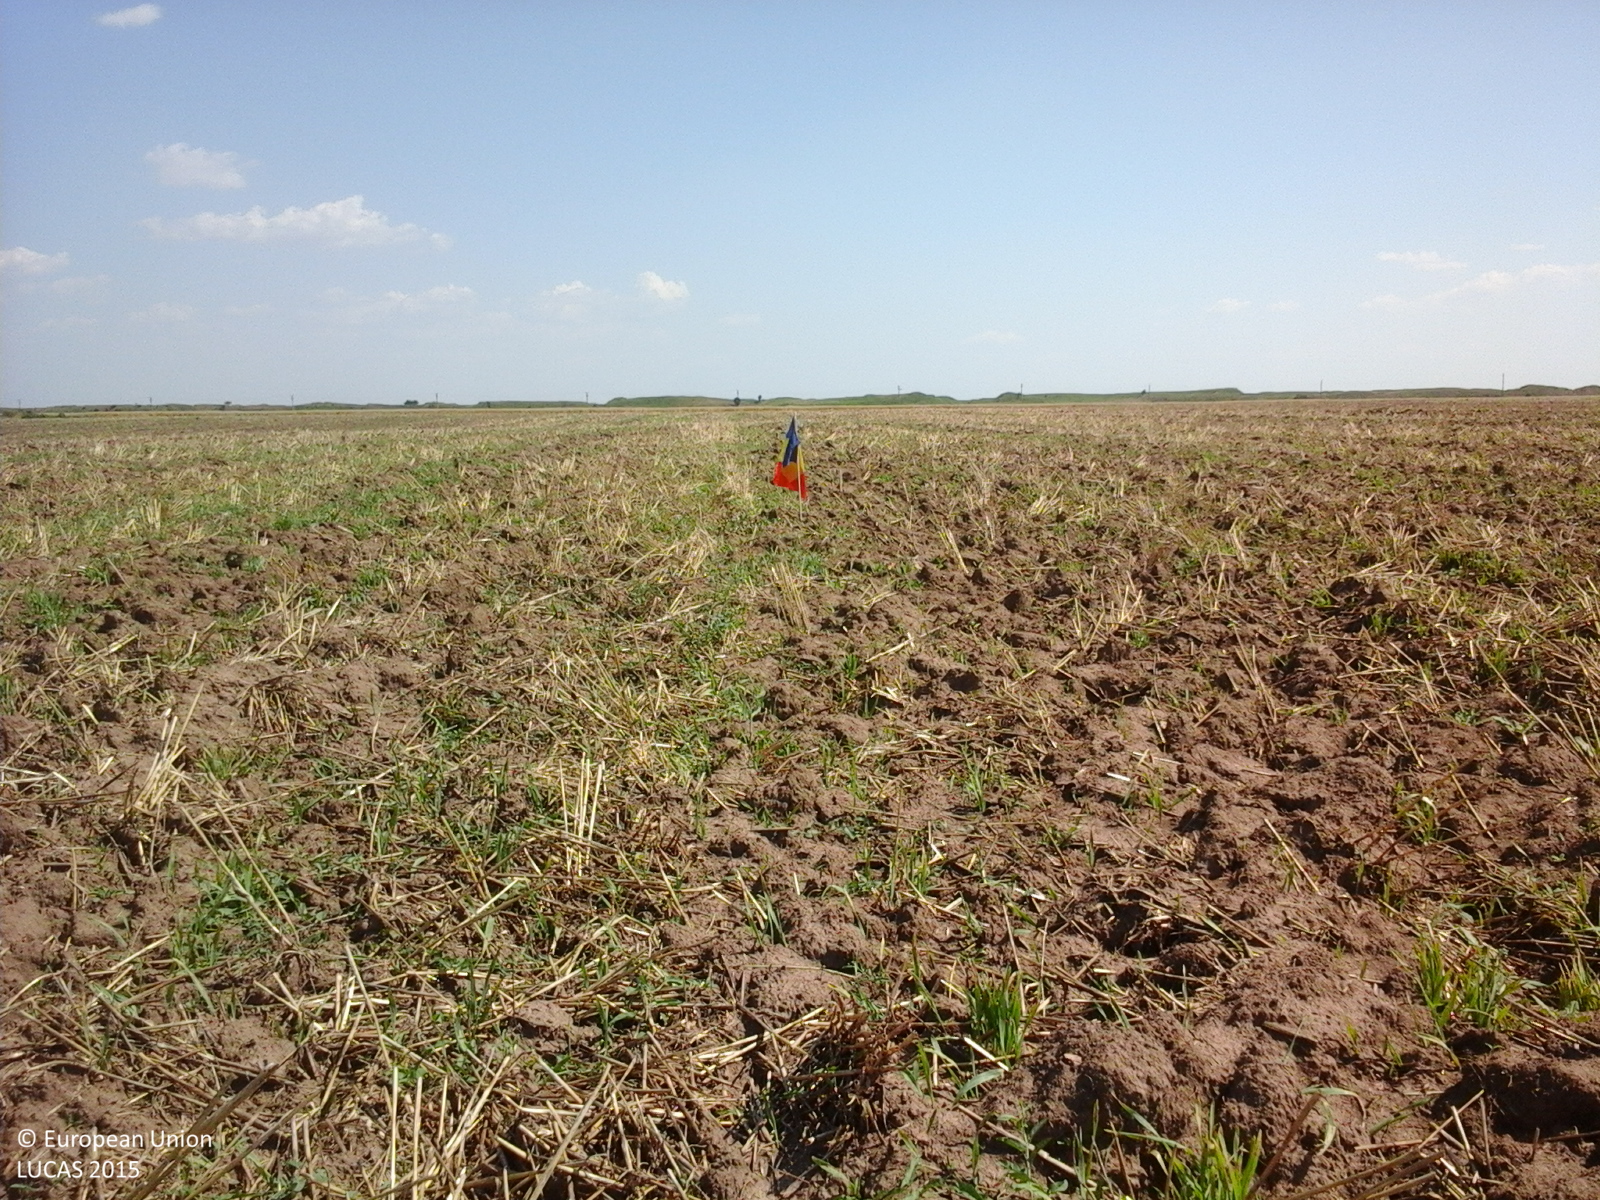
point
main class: Cropland
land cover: Durum wheat
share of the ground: < 10 %
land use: Agriculture (excluding fallow land and kitchen gardens)
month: July
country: RO
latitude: 44.1977
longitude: 24.5462
